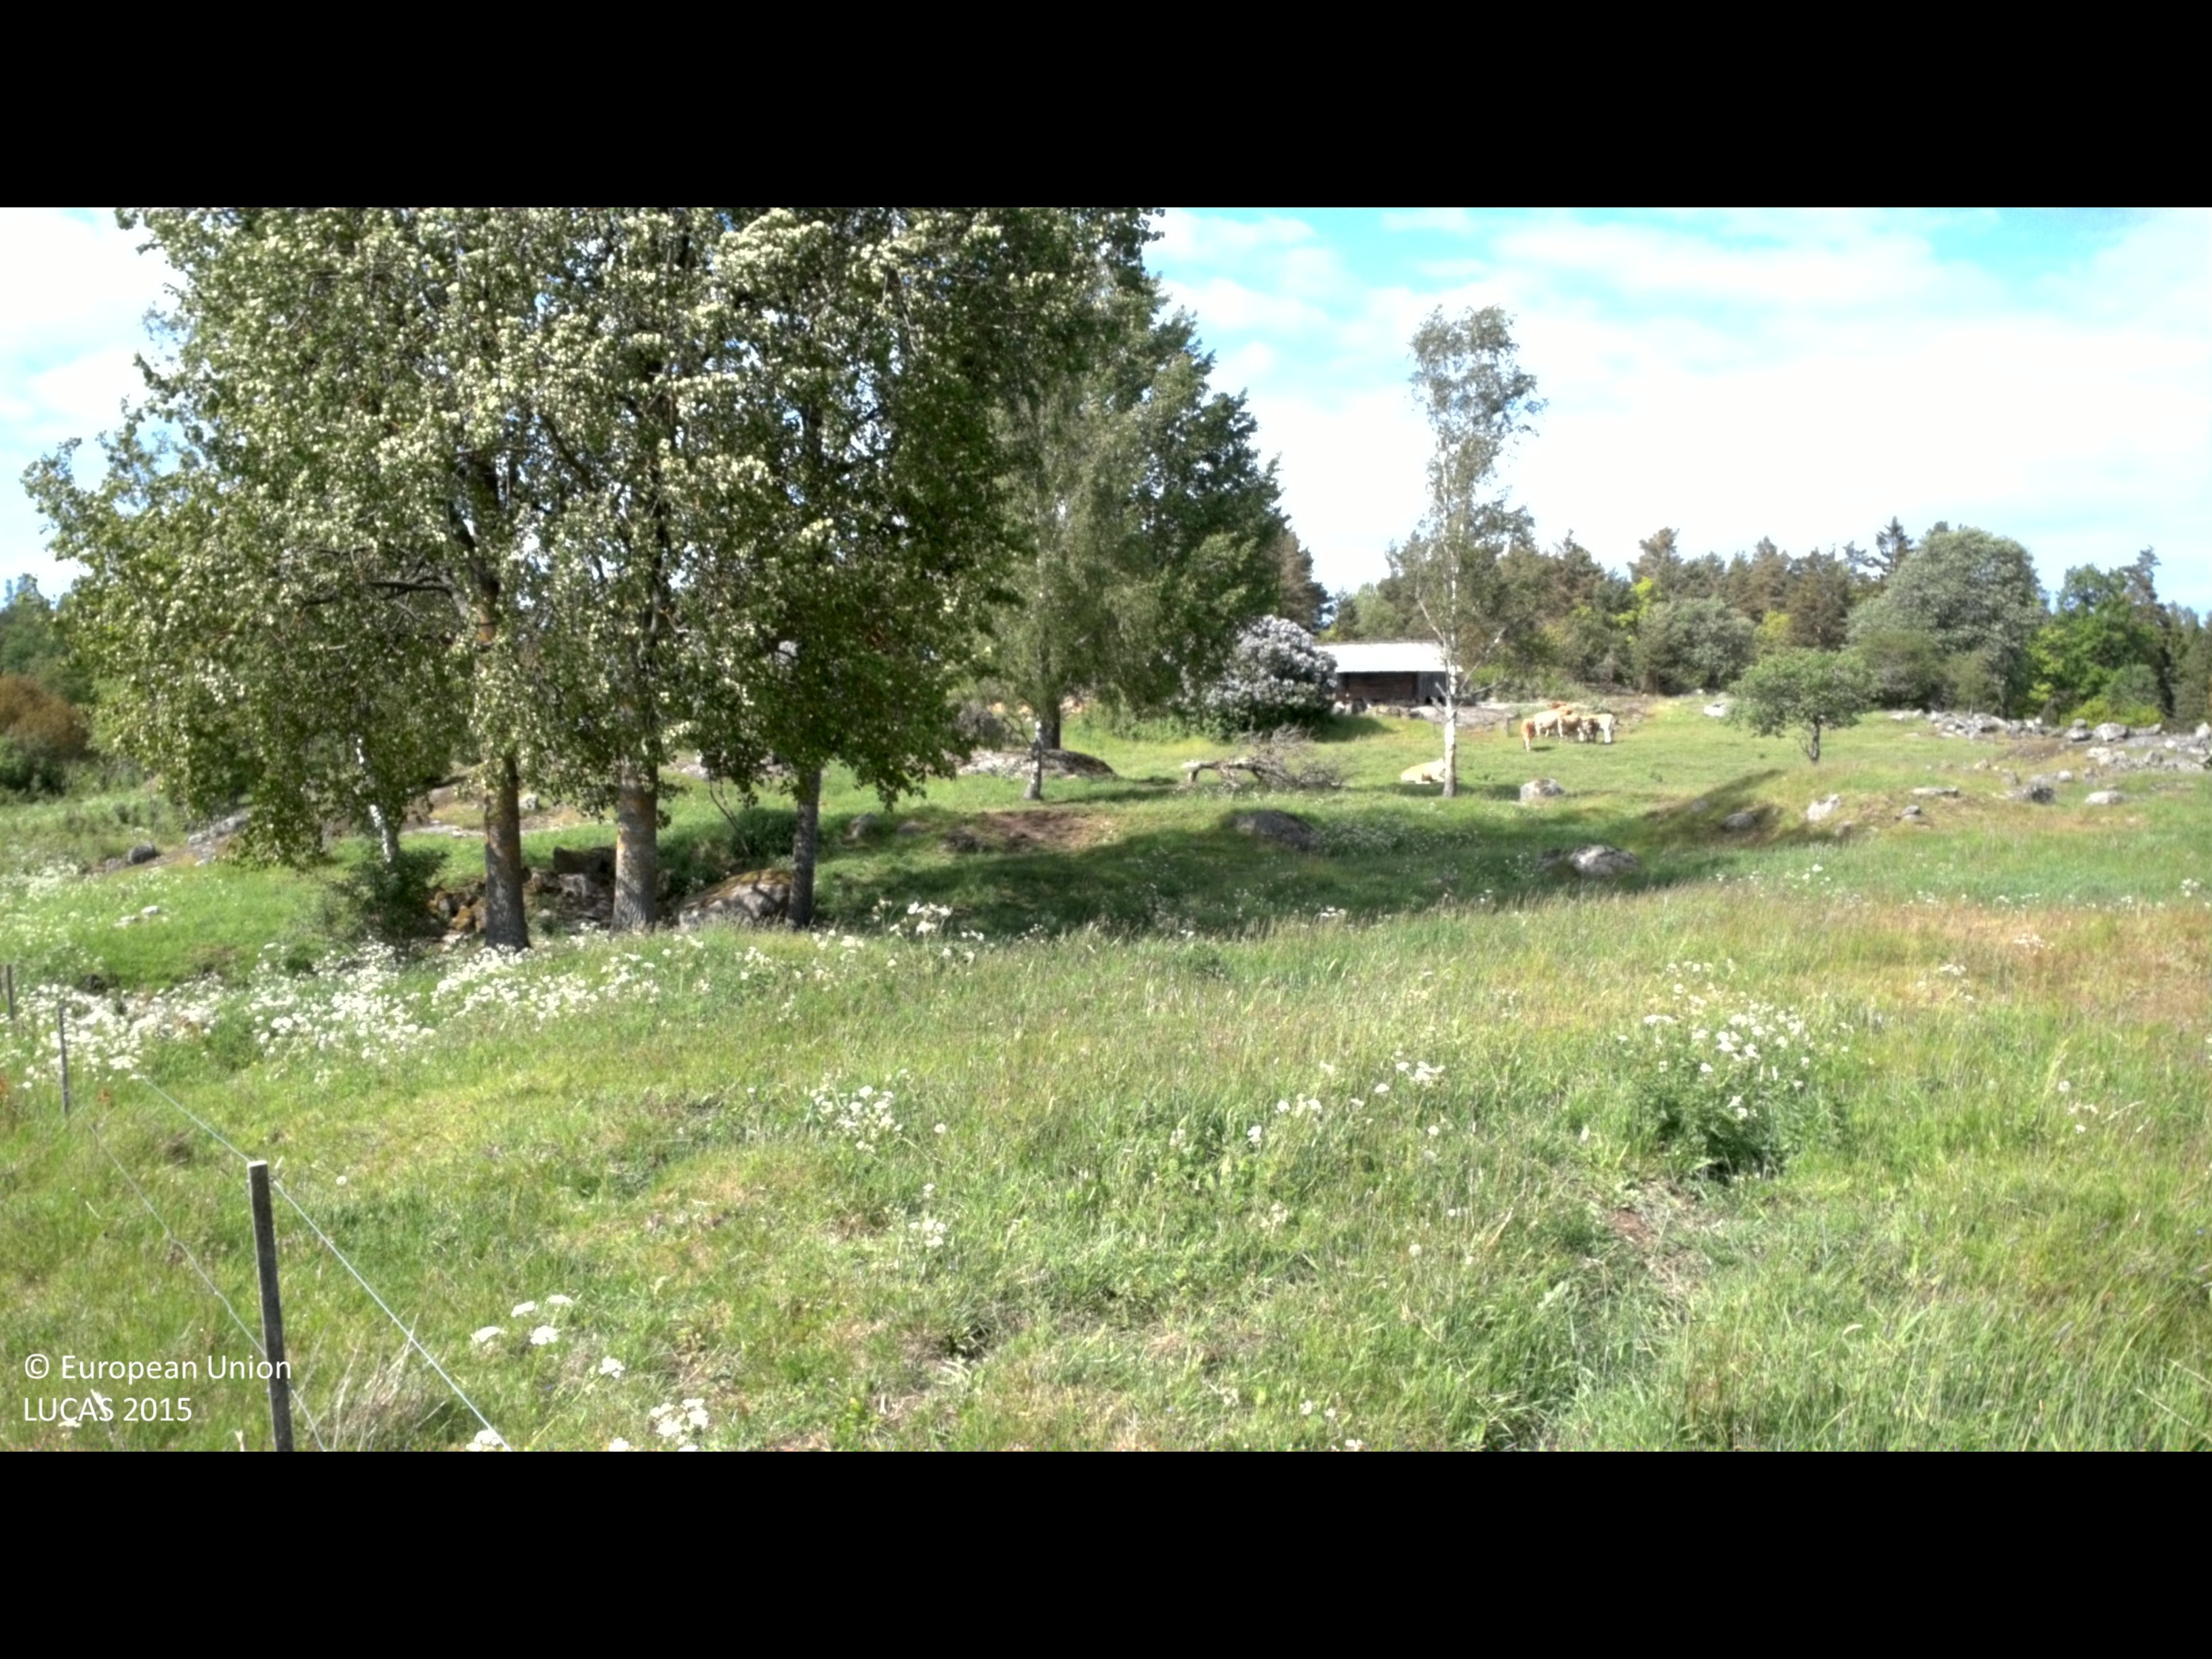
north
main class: Grassland
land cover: Grassland with sparse tree/shrub cover
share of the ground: > 75 %
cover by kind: herbaceous plants 90 %, broadleaved forest trees 5 %, shrubs 5 %
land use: Agriculture (excluding fallow land and kitchen gardens)
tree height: > 5 m
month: May
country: SE
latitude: 57.5389
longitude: 16.4973
